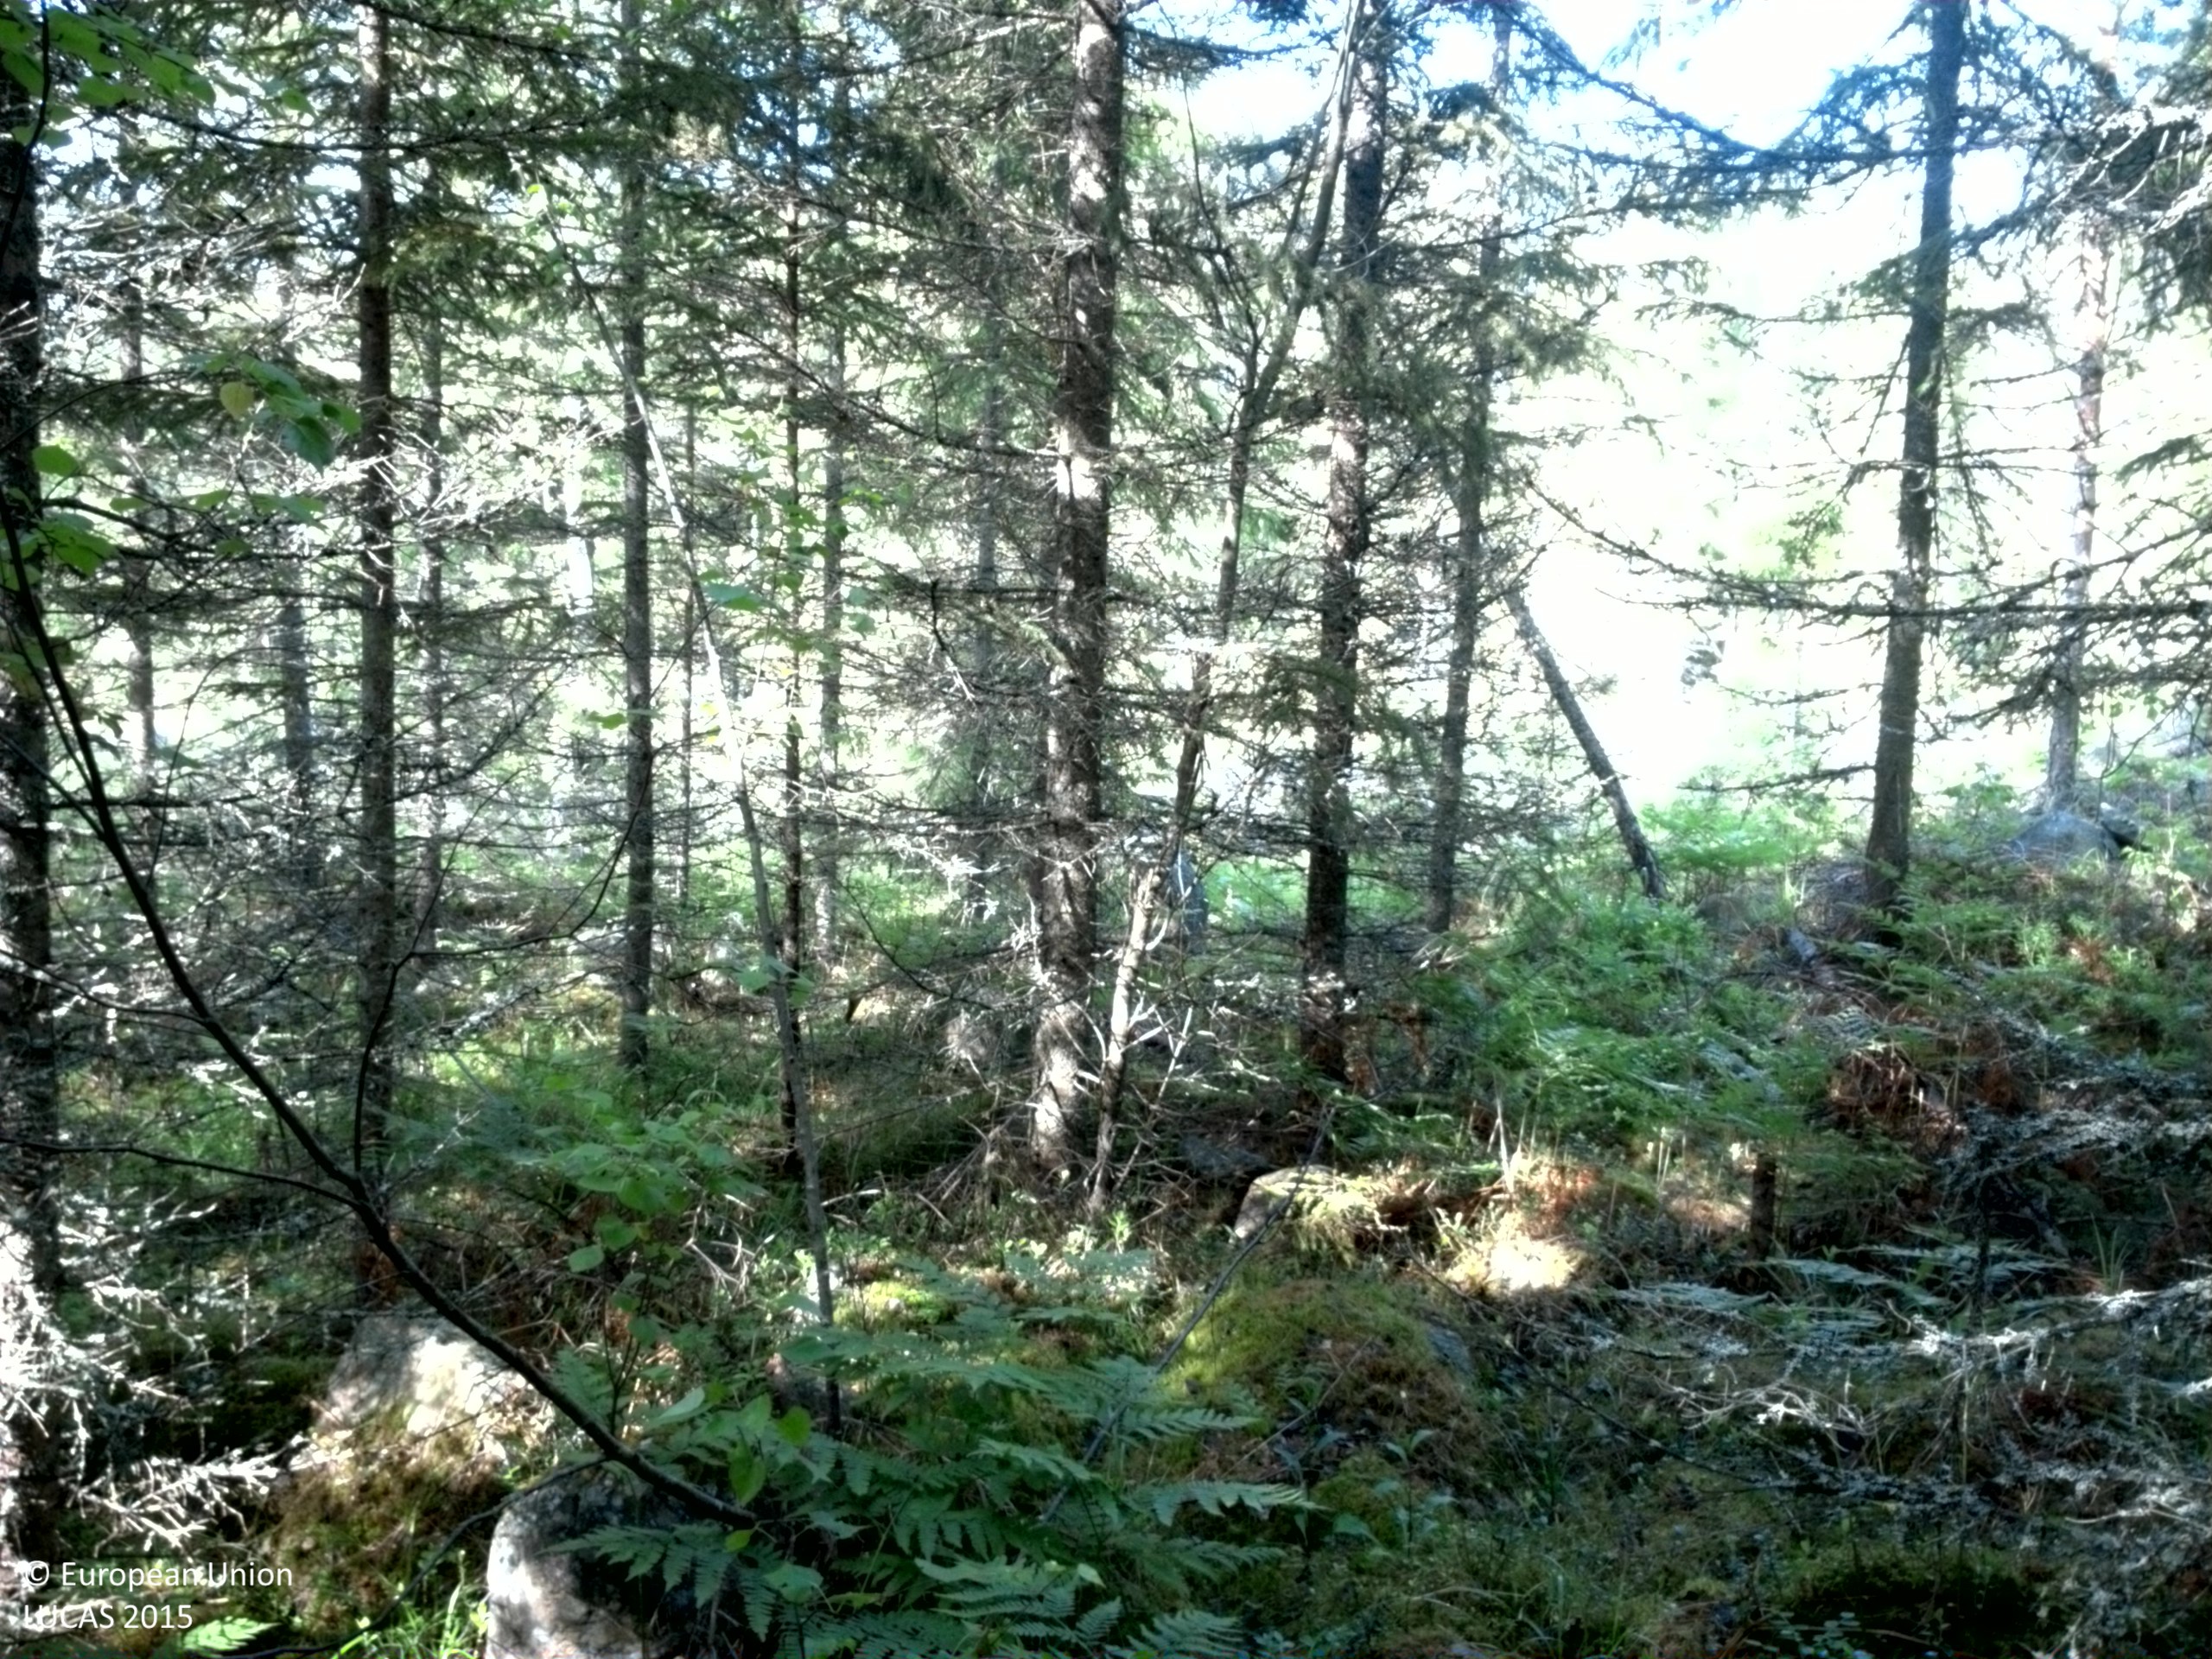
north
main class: Woodland
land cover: Spruce dominated coniferous woodland
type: boreal forest
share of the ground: > 75 %
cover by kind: coniferous forest trees 75 %, shrubs 10 %, lichens and mosses 10 %, herbaceous plants 5 %
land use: Forestry
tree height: > 5 m
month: June
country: SE
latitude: 60.3704
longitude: 17.6624
